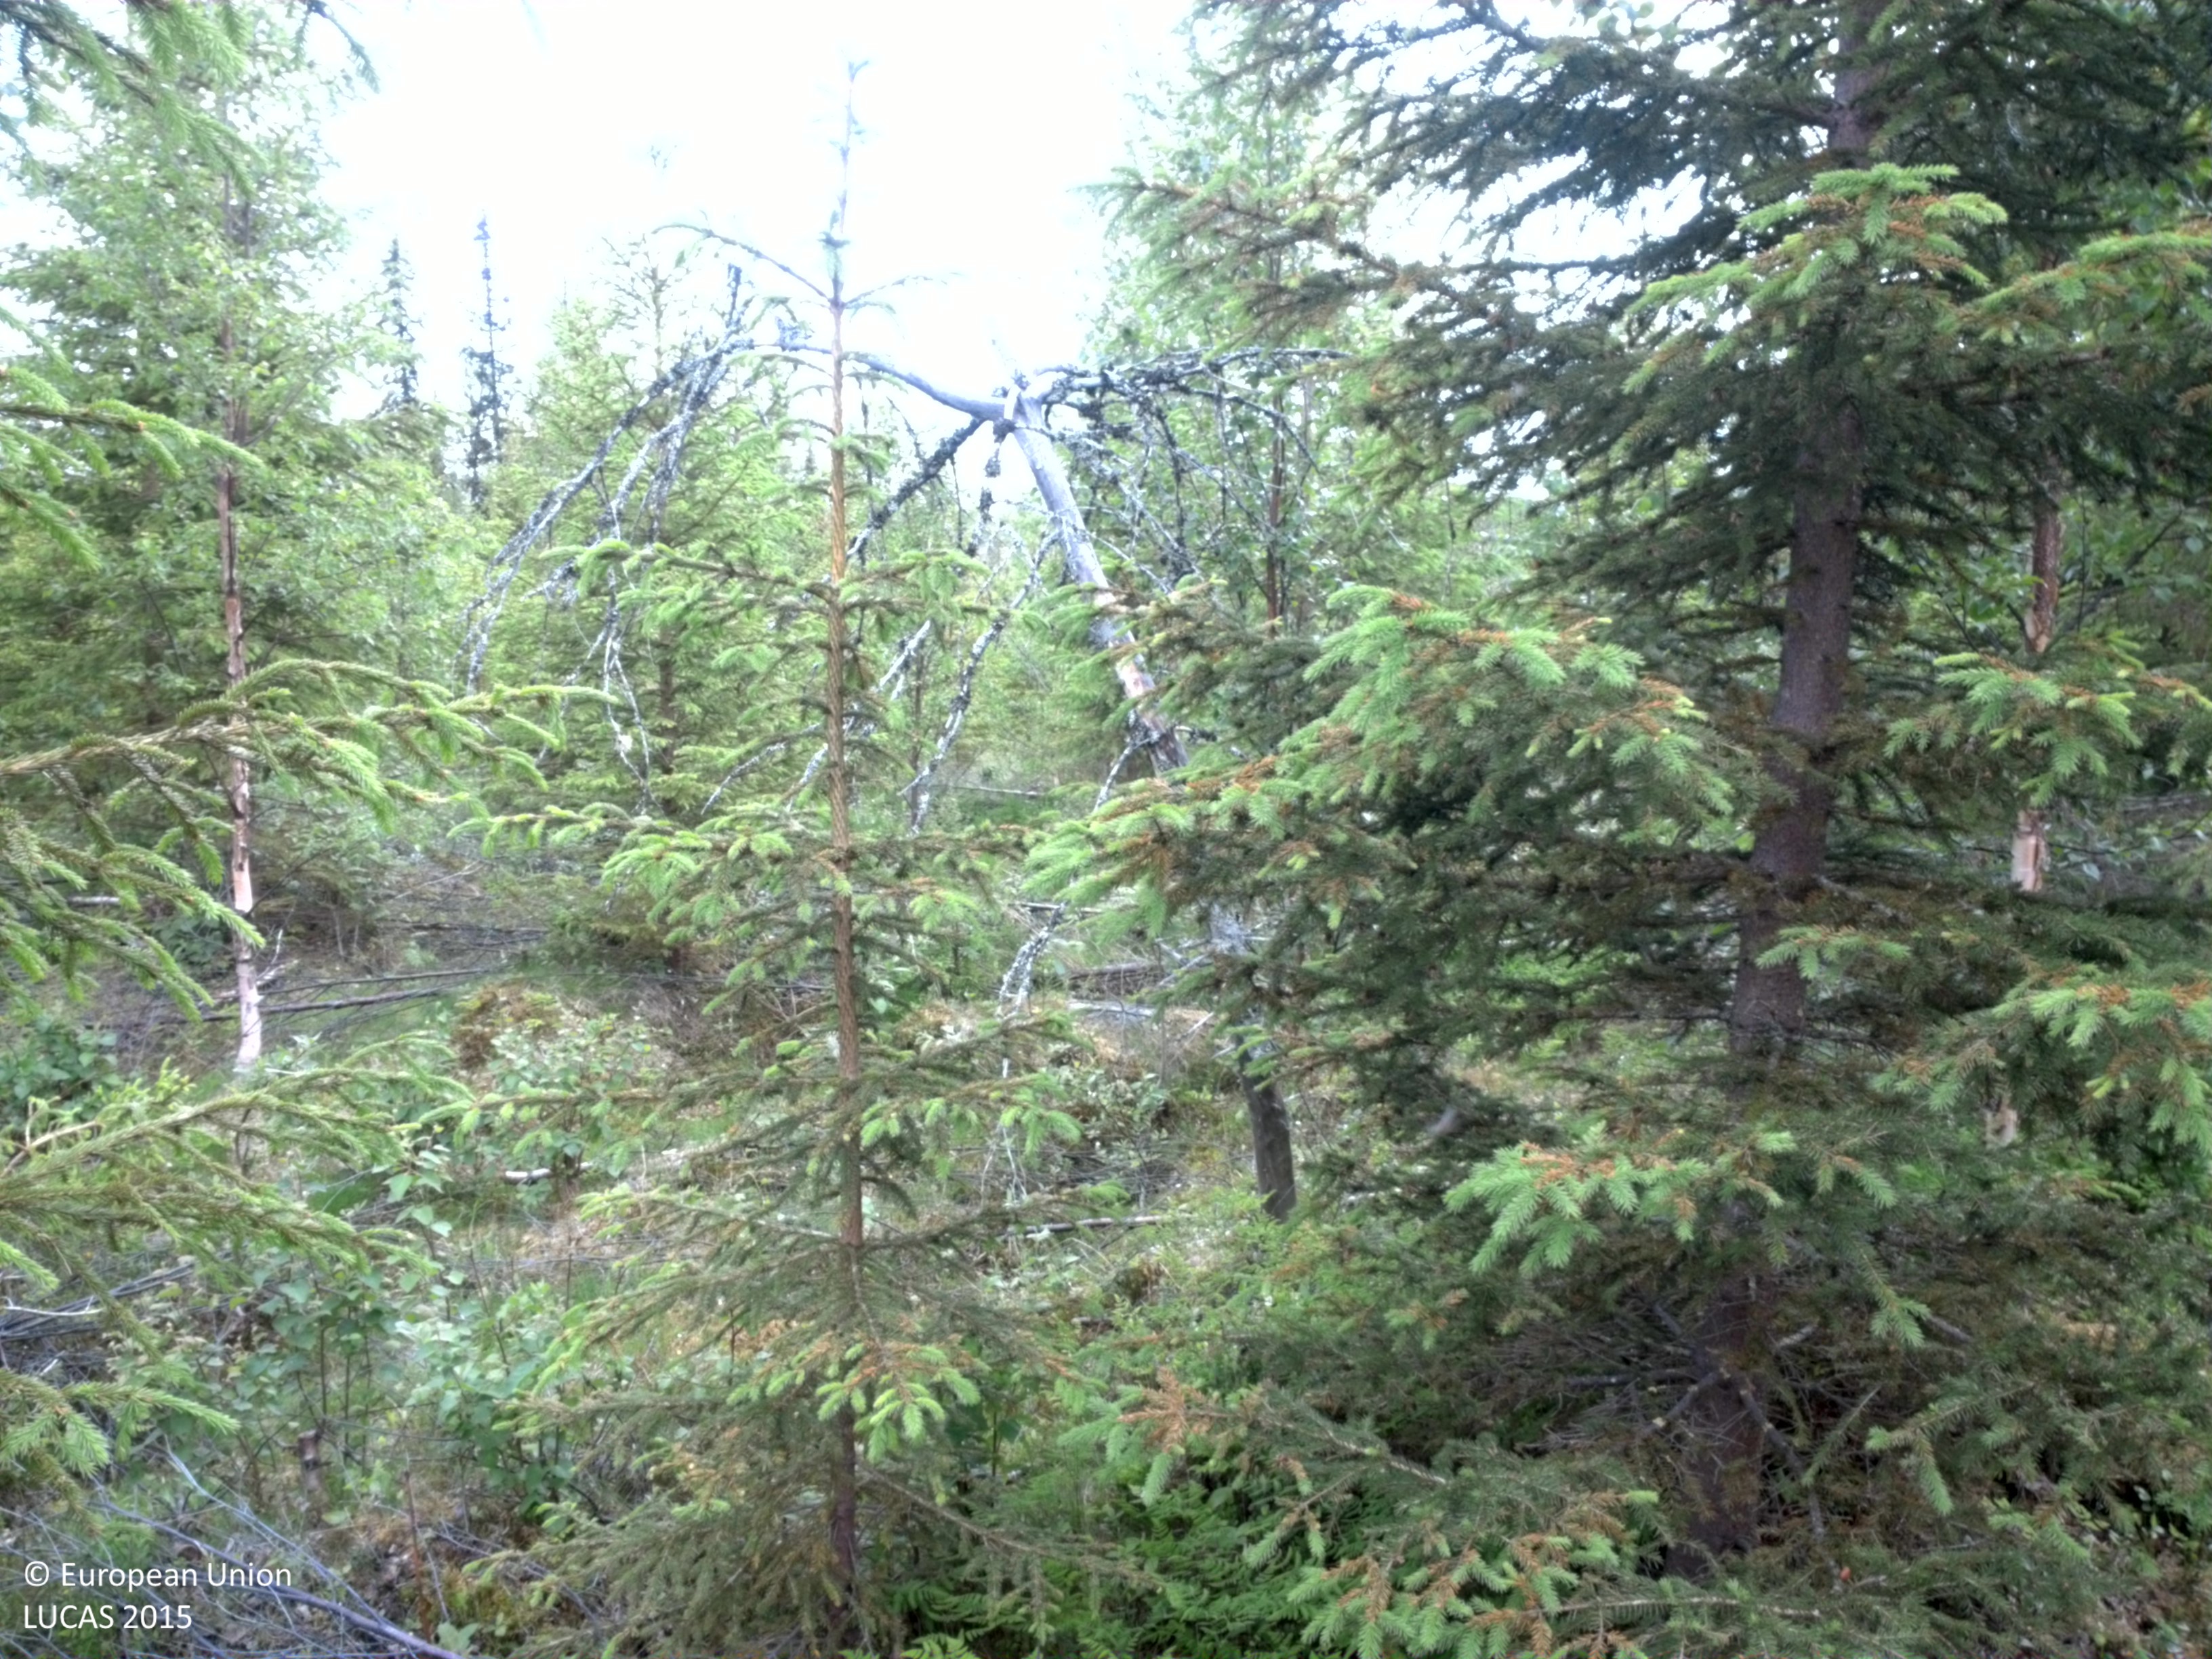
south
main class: Woodland
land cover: Spruce dominated mixed woodland
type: boreal forest
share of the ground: 50 - 75 %
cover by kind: coniferous forest trees 45 %, herbaceous plants 20 %, broadleaved forest trees 15 %, shrubs 15 %, lichens and mosses 5 %
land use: Forestry
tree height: > 5 m
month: July
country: SE
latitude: 64.5375
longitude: 18.0768
